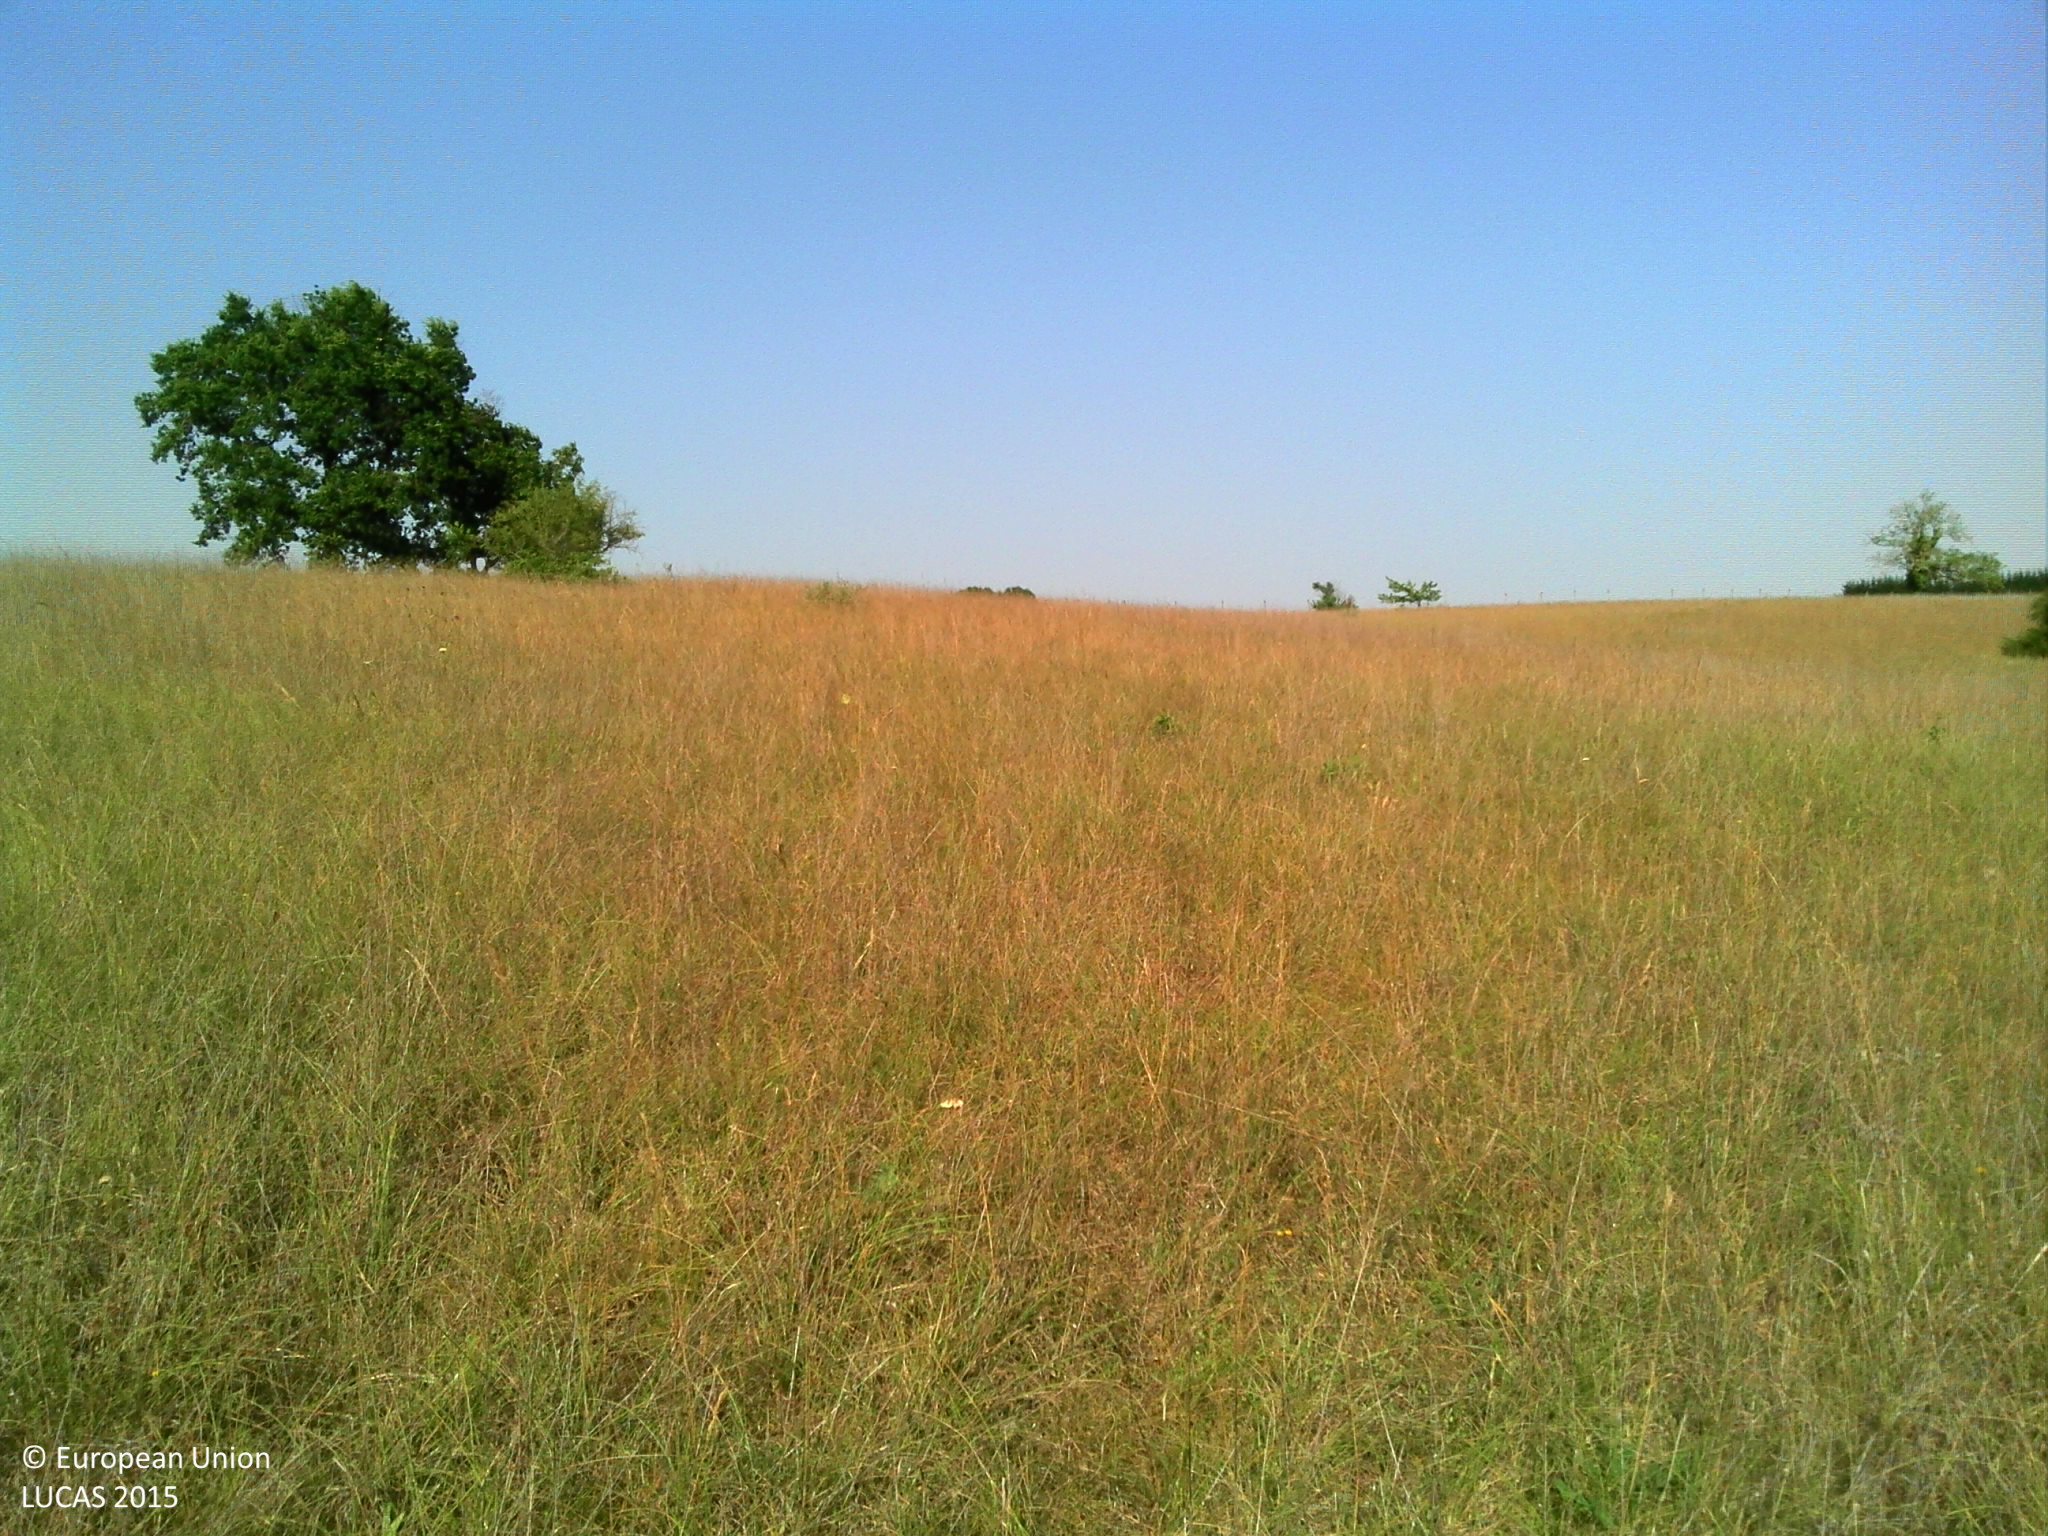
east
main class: Grassland
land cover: Grassland with sparse tree/shrub cover
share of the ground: > 75 %
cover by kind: herbaceous plants 90 %, broadleaved forest trees 5 %, shrubs 5 %
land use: Agriculture (excluding fallow land and kitchen gardens)
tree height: < 5 m
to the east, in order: Grassland with sparse tree/shrub cover; Grassland without tree/shrub cover; Abandoned hedges; Grassland without tree/shrub cover
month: July
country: FR
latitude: 44.4229
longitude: 0.9141
